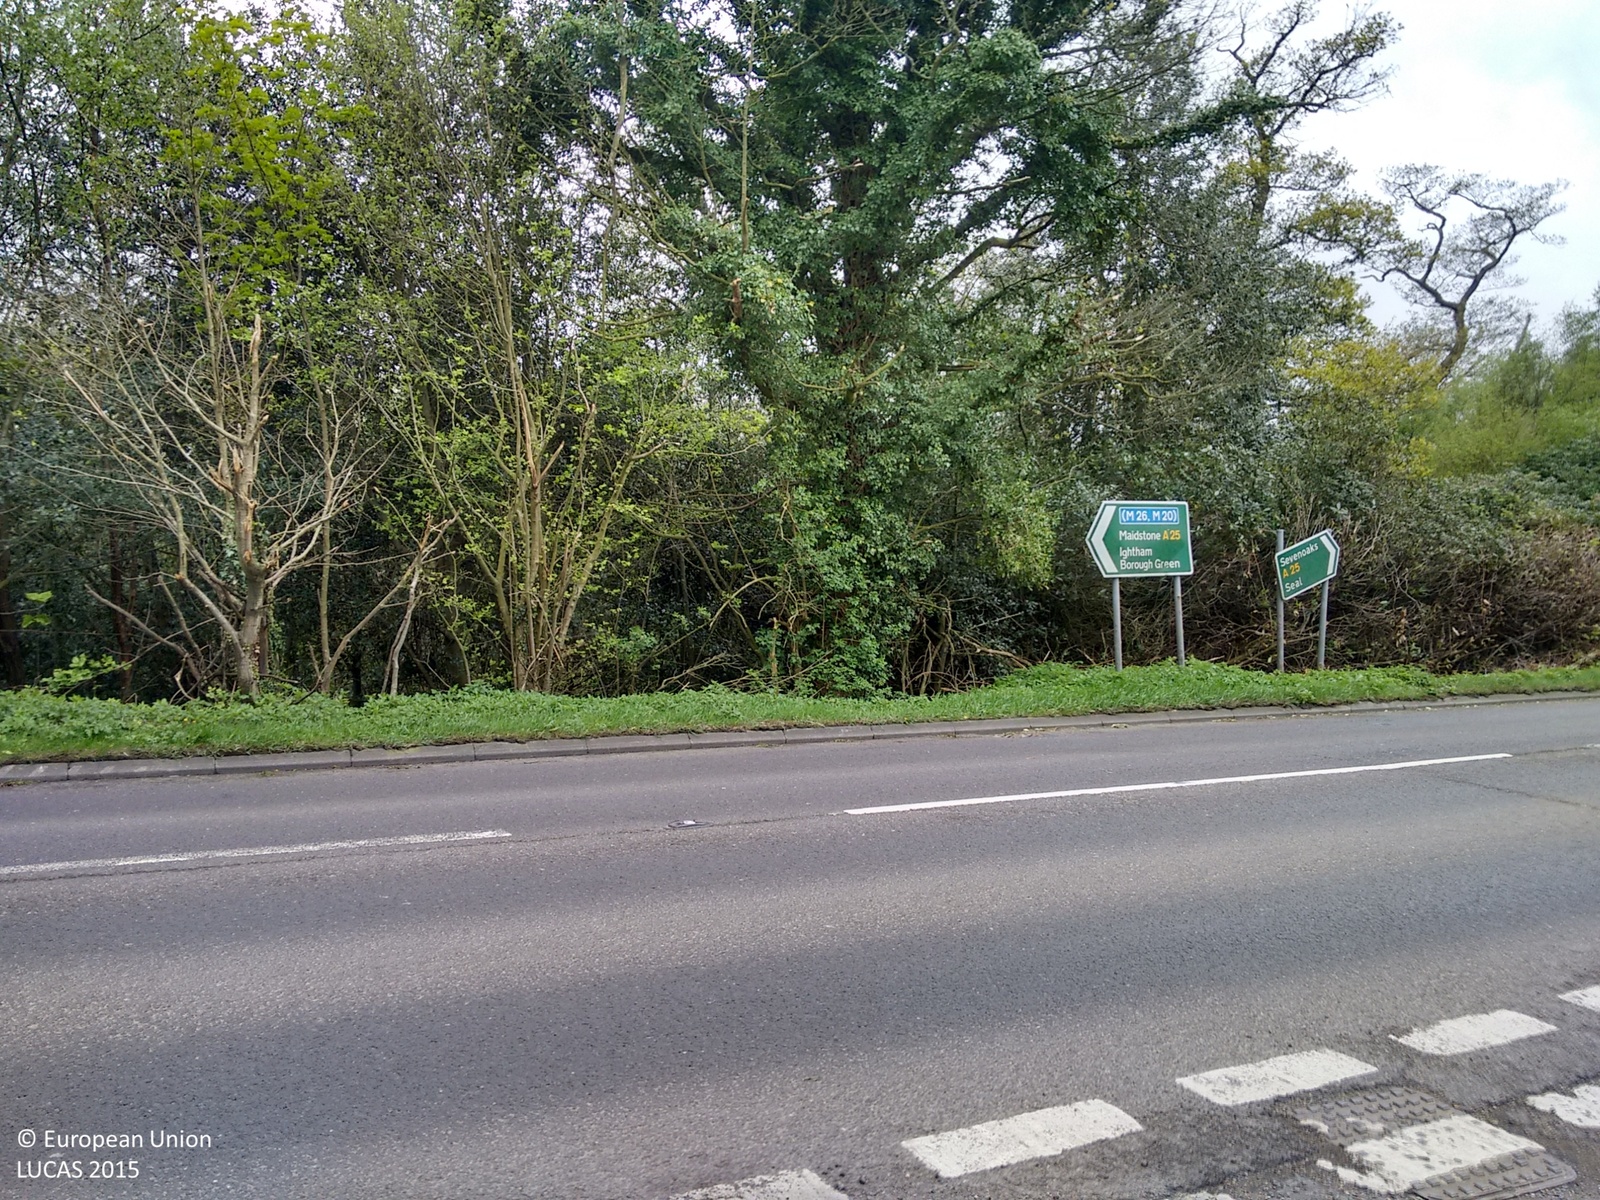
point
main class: Woodland
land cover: Broadleaved woodland
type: mesophytic deciduous forest
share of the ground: > 75 %
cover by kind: broadleaved forest trees 80 %, shrubs 20 %
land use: Forestry
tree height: > 5 m
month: May
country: GB
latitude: 51.2856
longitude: 0.2339
